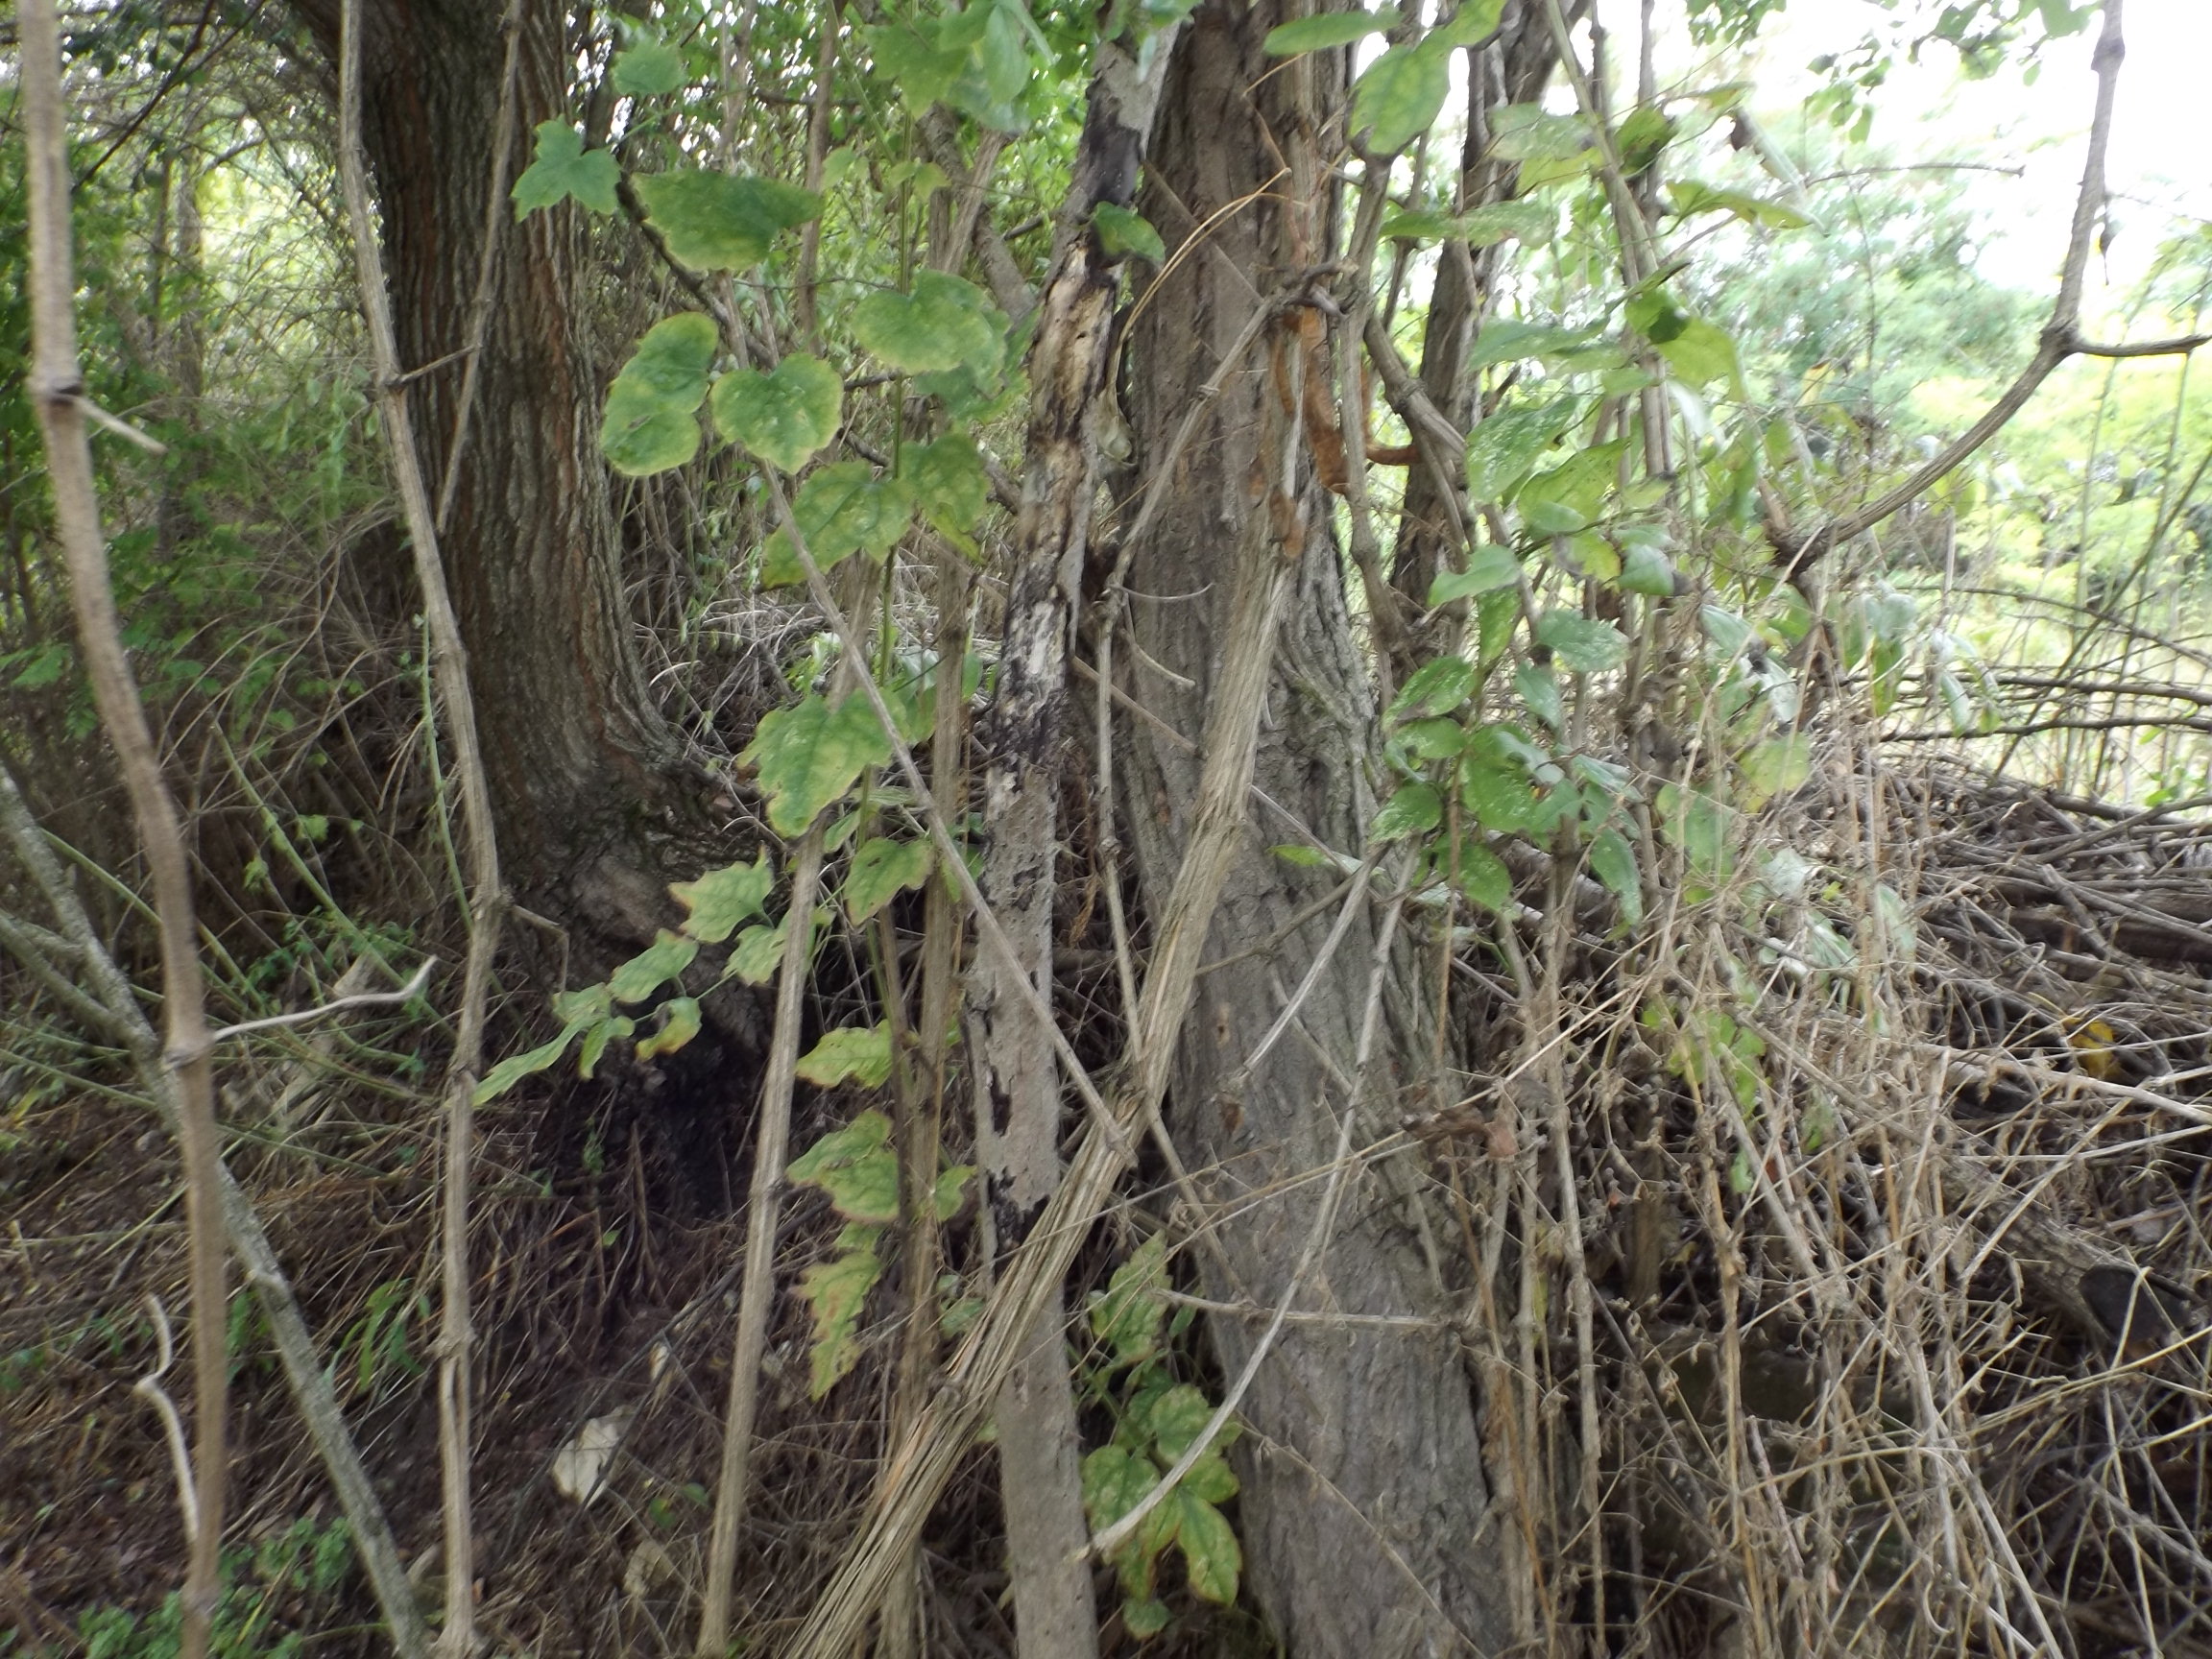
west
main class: Grassland
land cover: Grassland with sparse tree/shrub cover
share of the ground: > 75 %
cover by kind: herbaceous plants 90 %, broadleaved forest trees 5 %, shrubs 5 %
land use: Residential
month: August
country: BG
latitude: 43.1790
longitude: 27.5107
